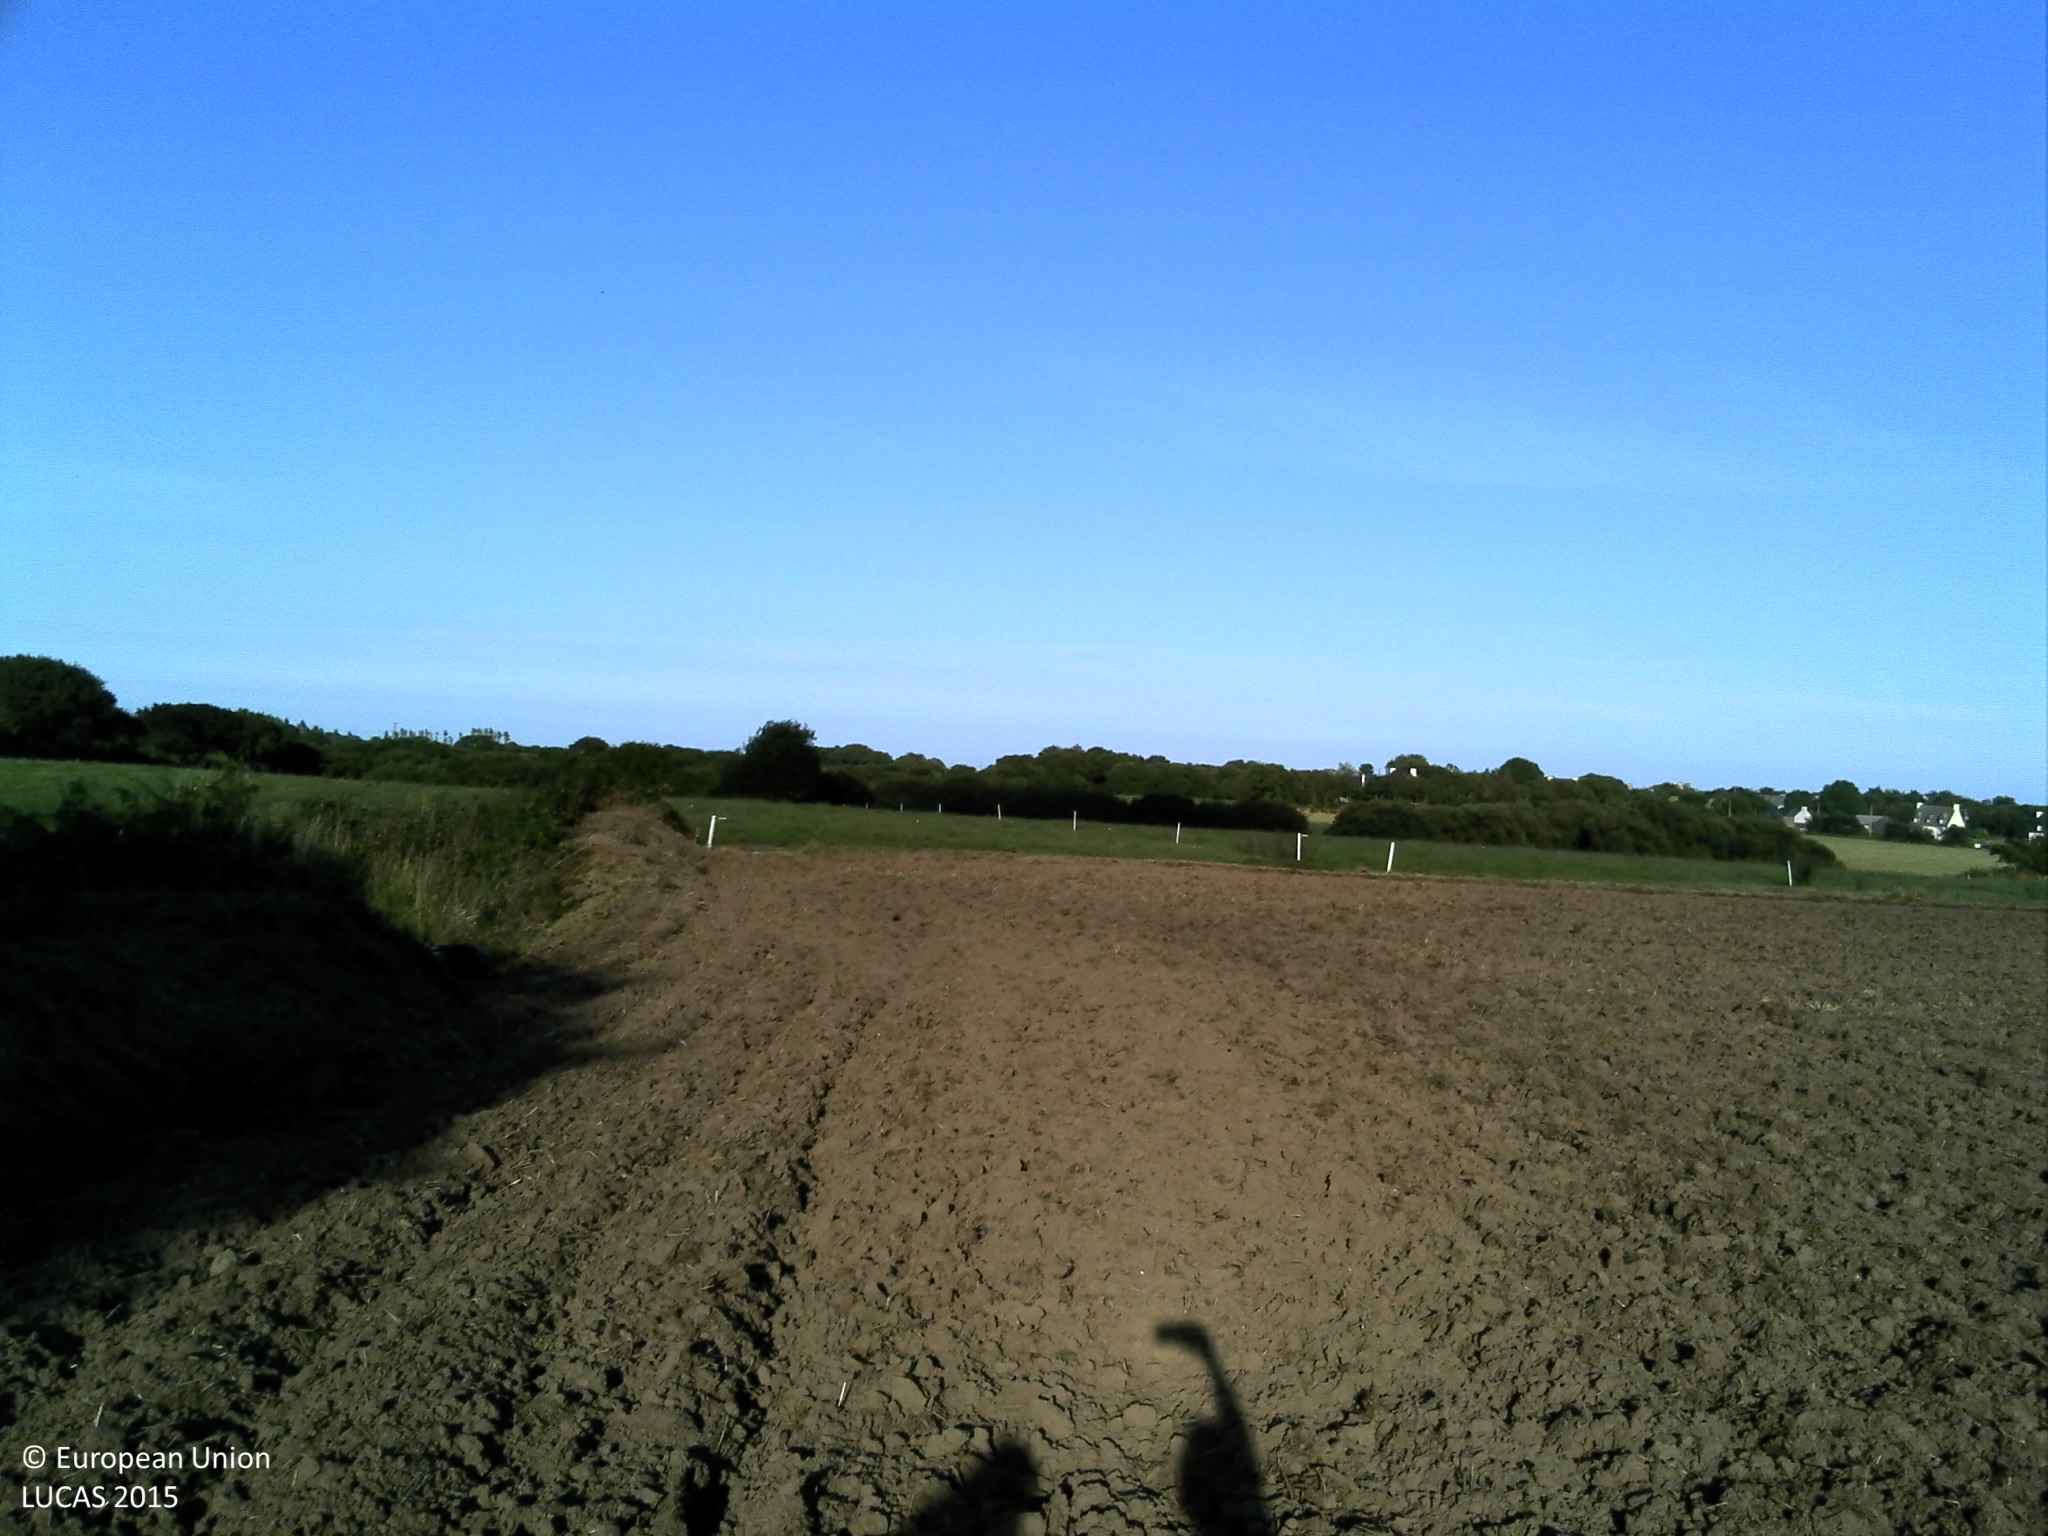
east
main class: Cropland
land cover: Barley
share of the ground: < 10 %
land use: Agriculture (excluding fallow land and kitchen gardens)
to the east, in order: Barley; Fences; Grass margins; Other bare soil; Grass margins; Fences; Grassland without tree/shrub cover; Fences; Grassland without tree/shrub cover; Fences; Grassland without tree/shrub cover
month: July
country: FR
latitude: 48.5032
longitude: -4.4860
